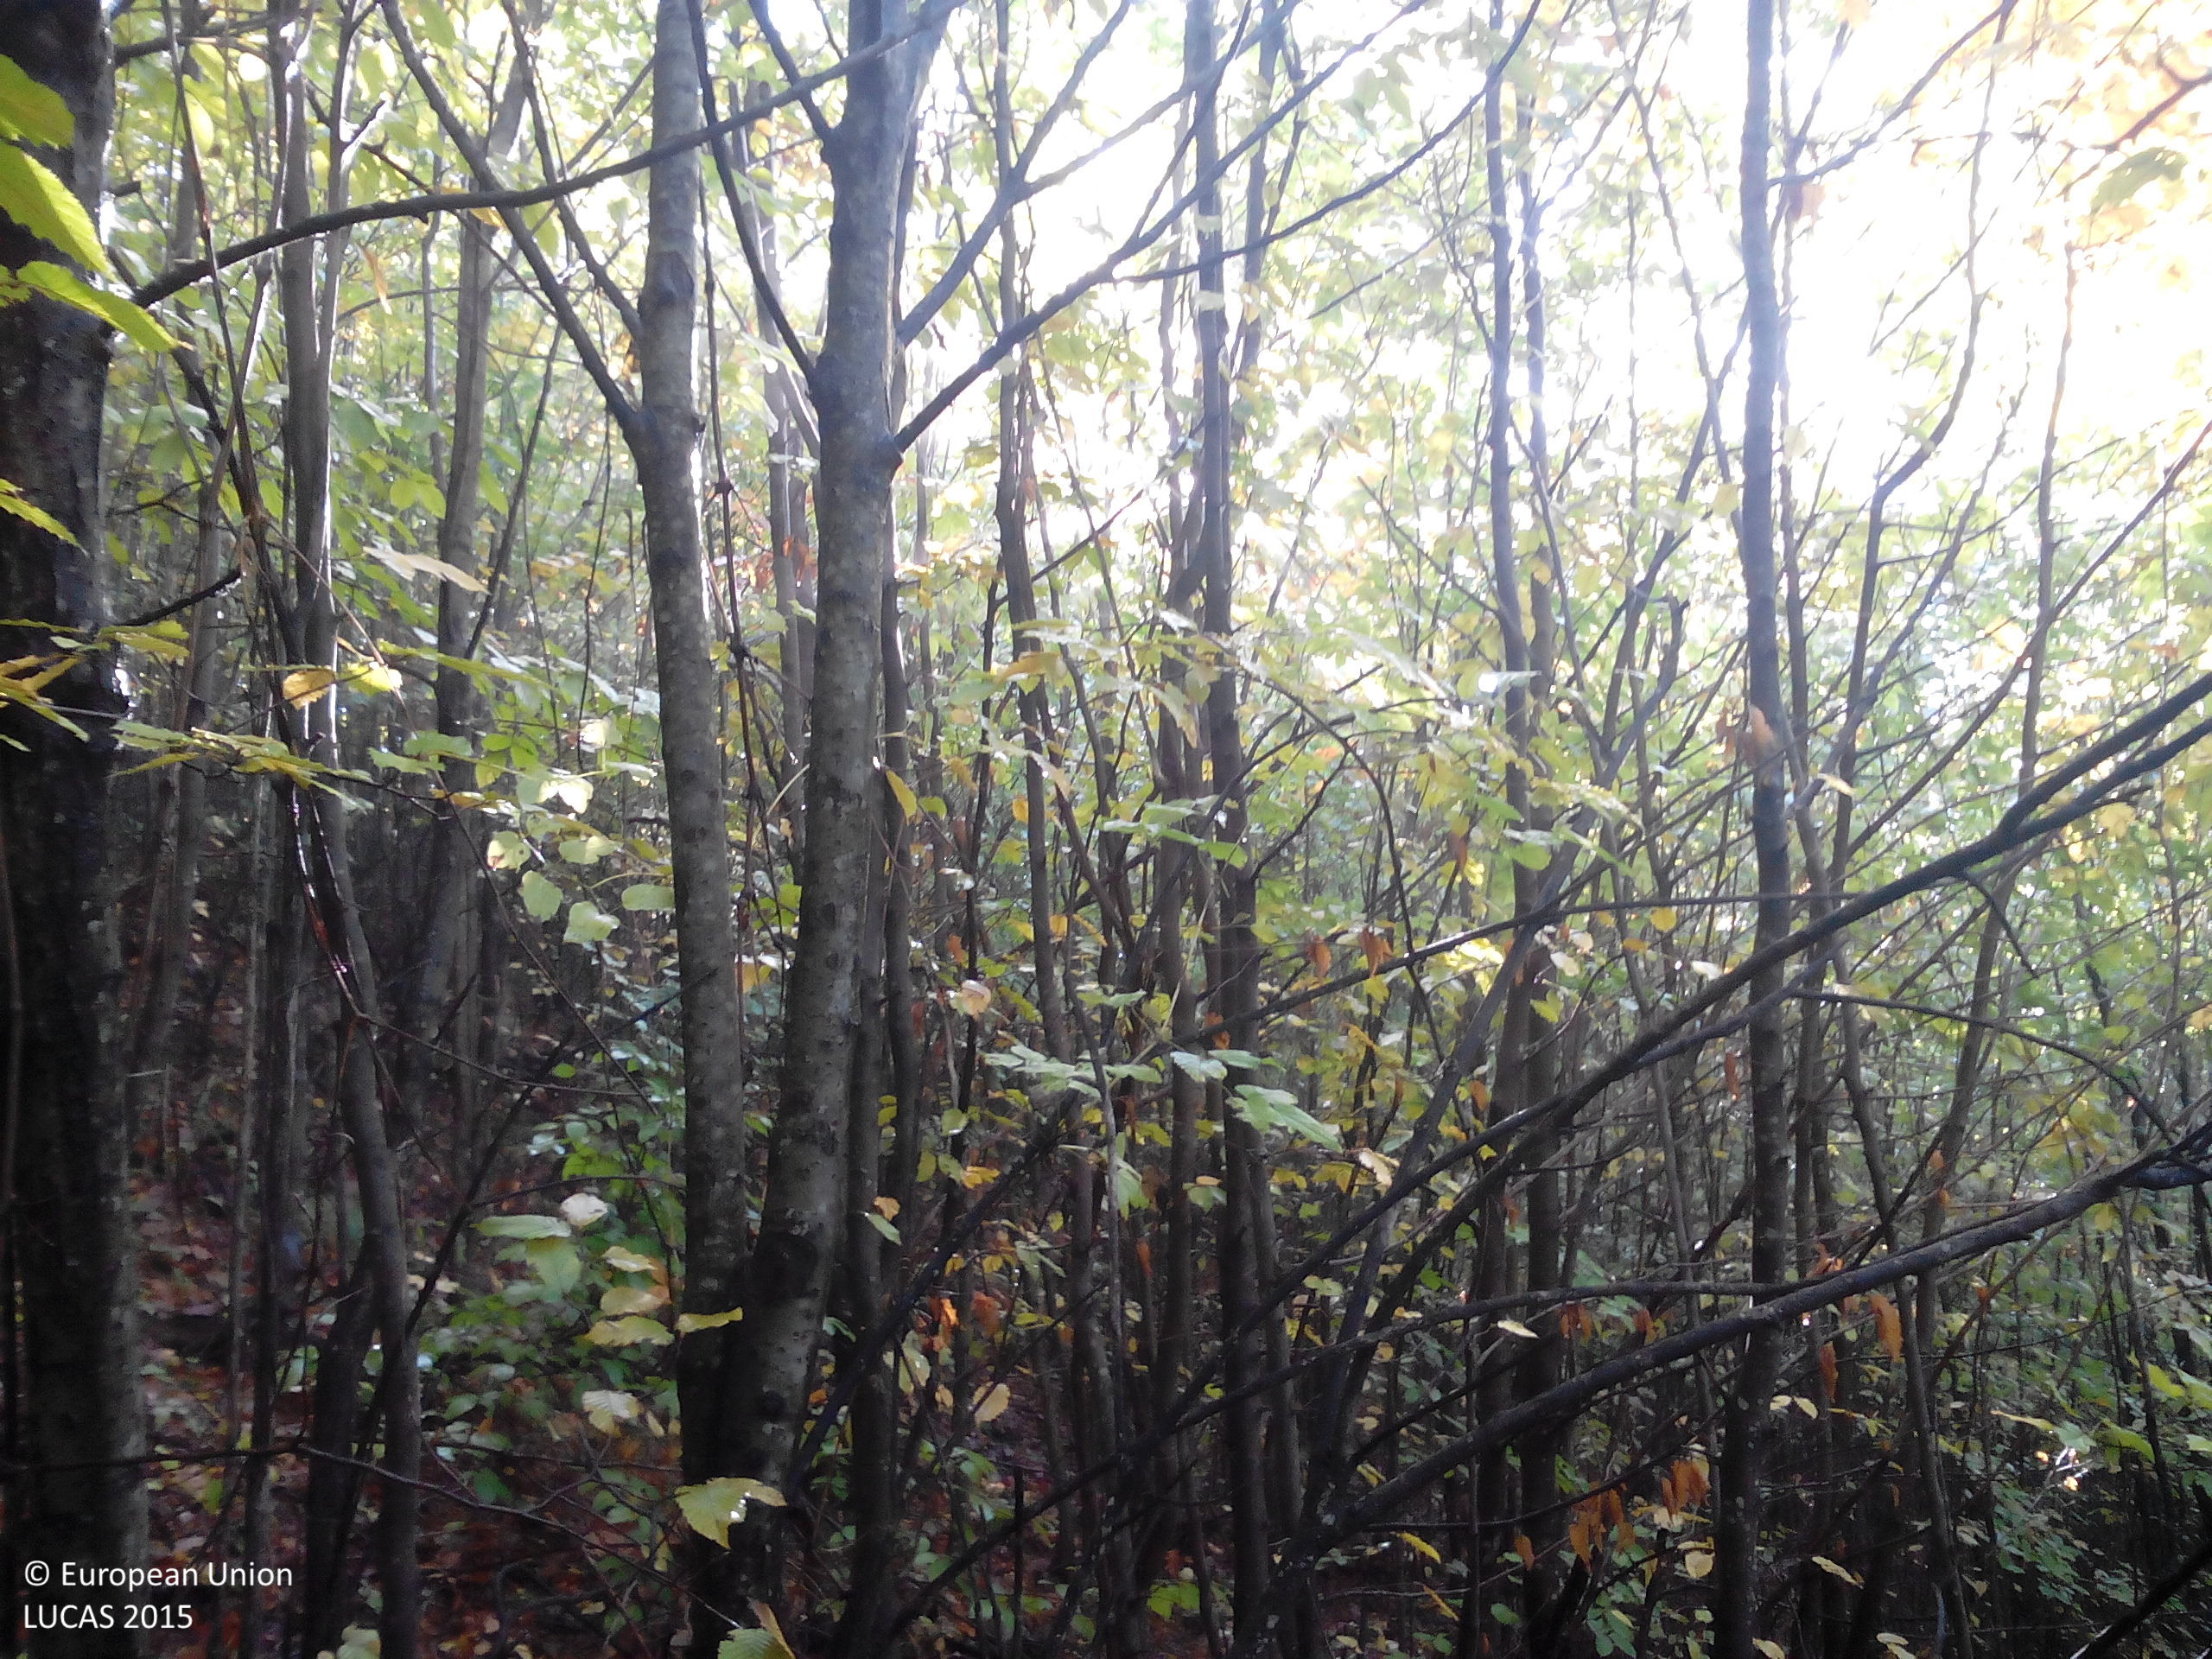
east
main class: Woodland
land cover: Broadleaved woodland
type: beech forest
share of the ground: > 75 %
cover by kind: broadleaved forest trees 95 %, shrubs 5 %
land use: Forestry
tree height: < 5 m
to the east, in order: Broadleaved woodland
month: October
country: BG
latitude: 42.8174
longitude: 24.7230
